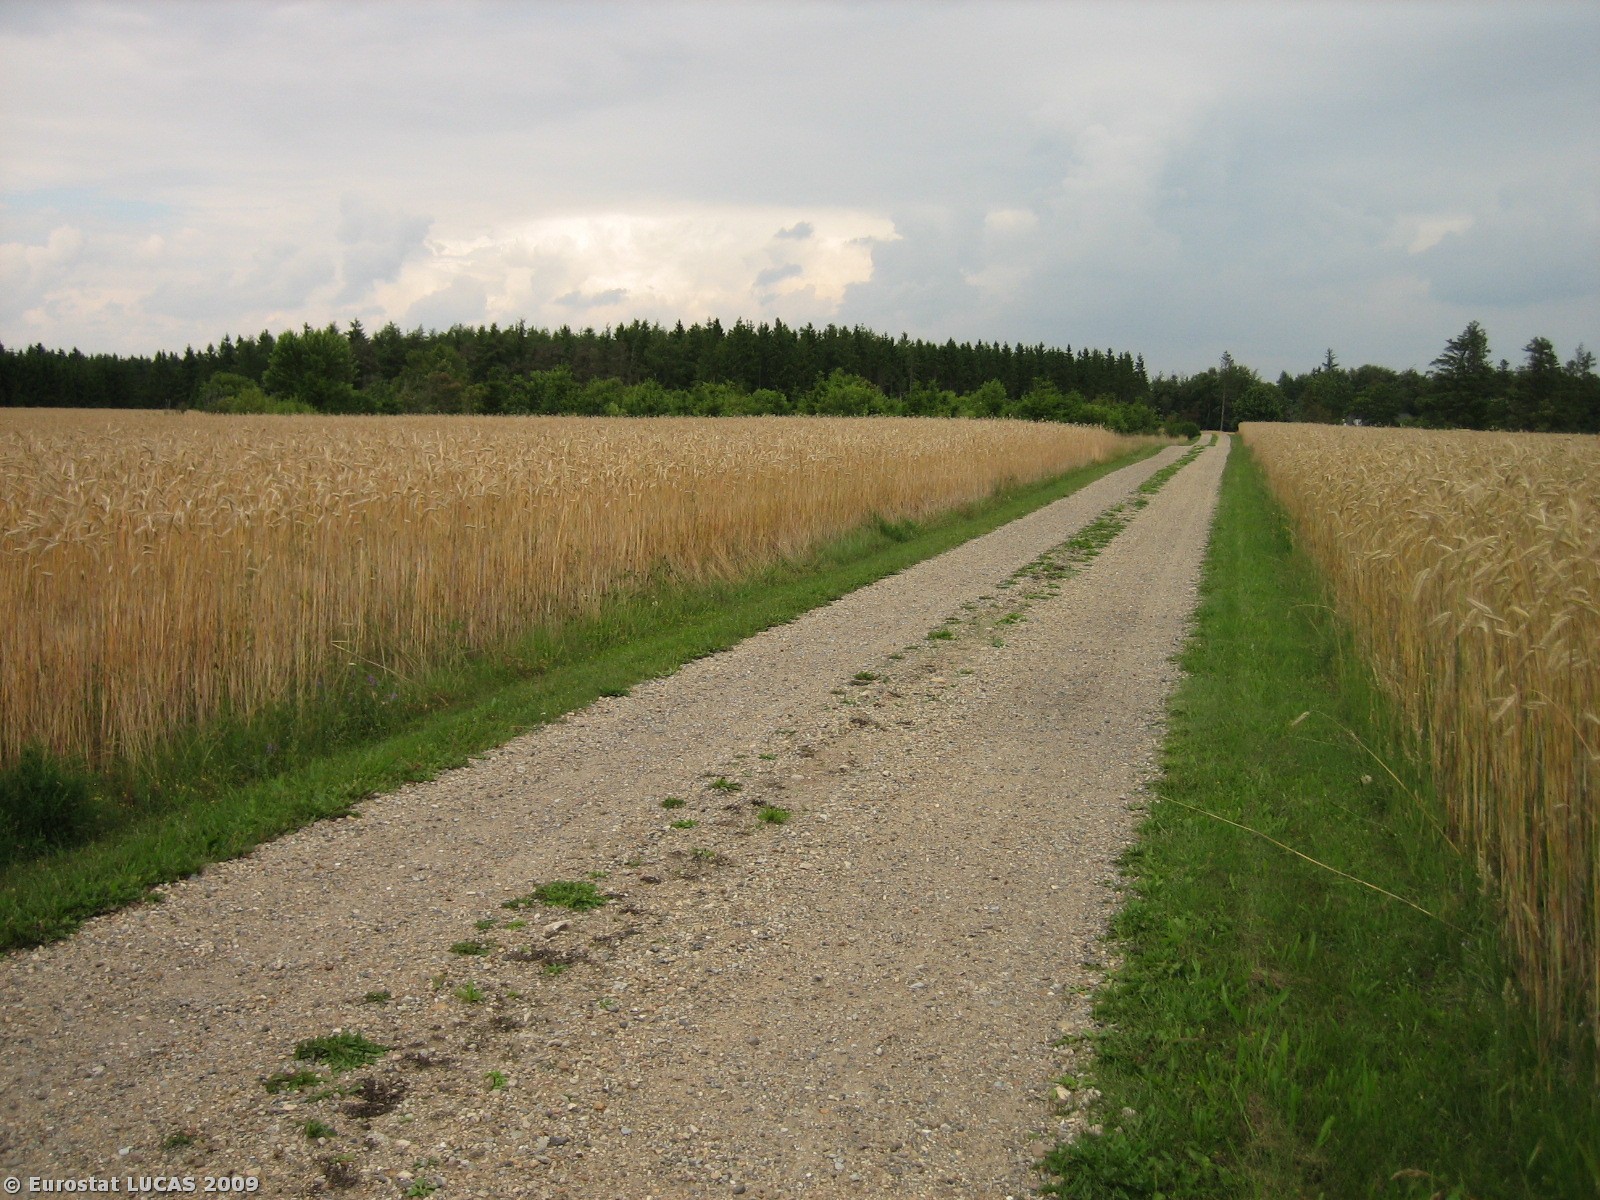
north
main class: Cropland
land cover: Rye
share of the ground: > 75 %
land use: Agriculture (excluding fallow land and kitchen gardens)
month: July
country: DK
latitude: 55.8580
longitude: 8.7392
